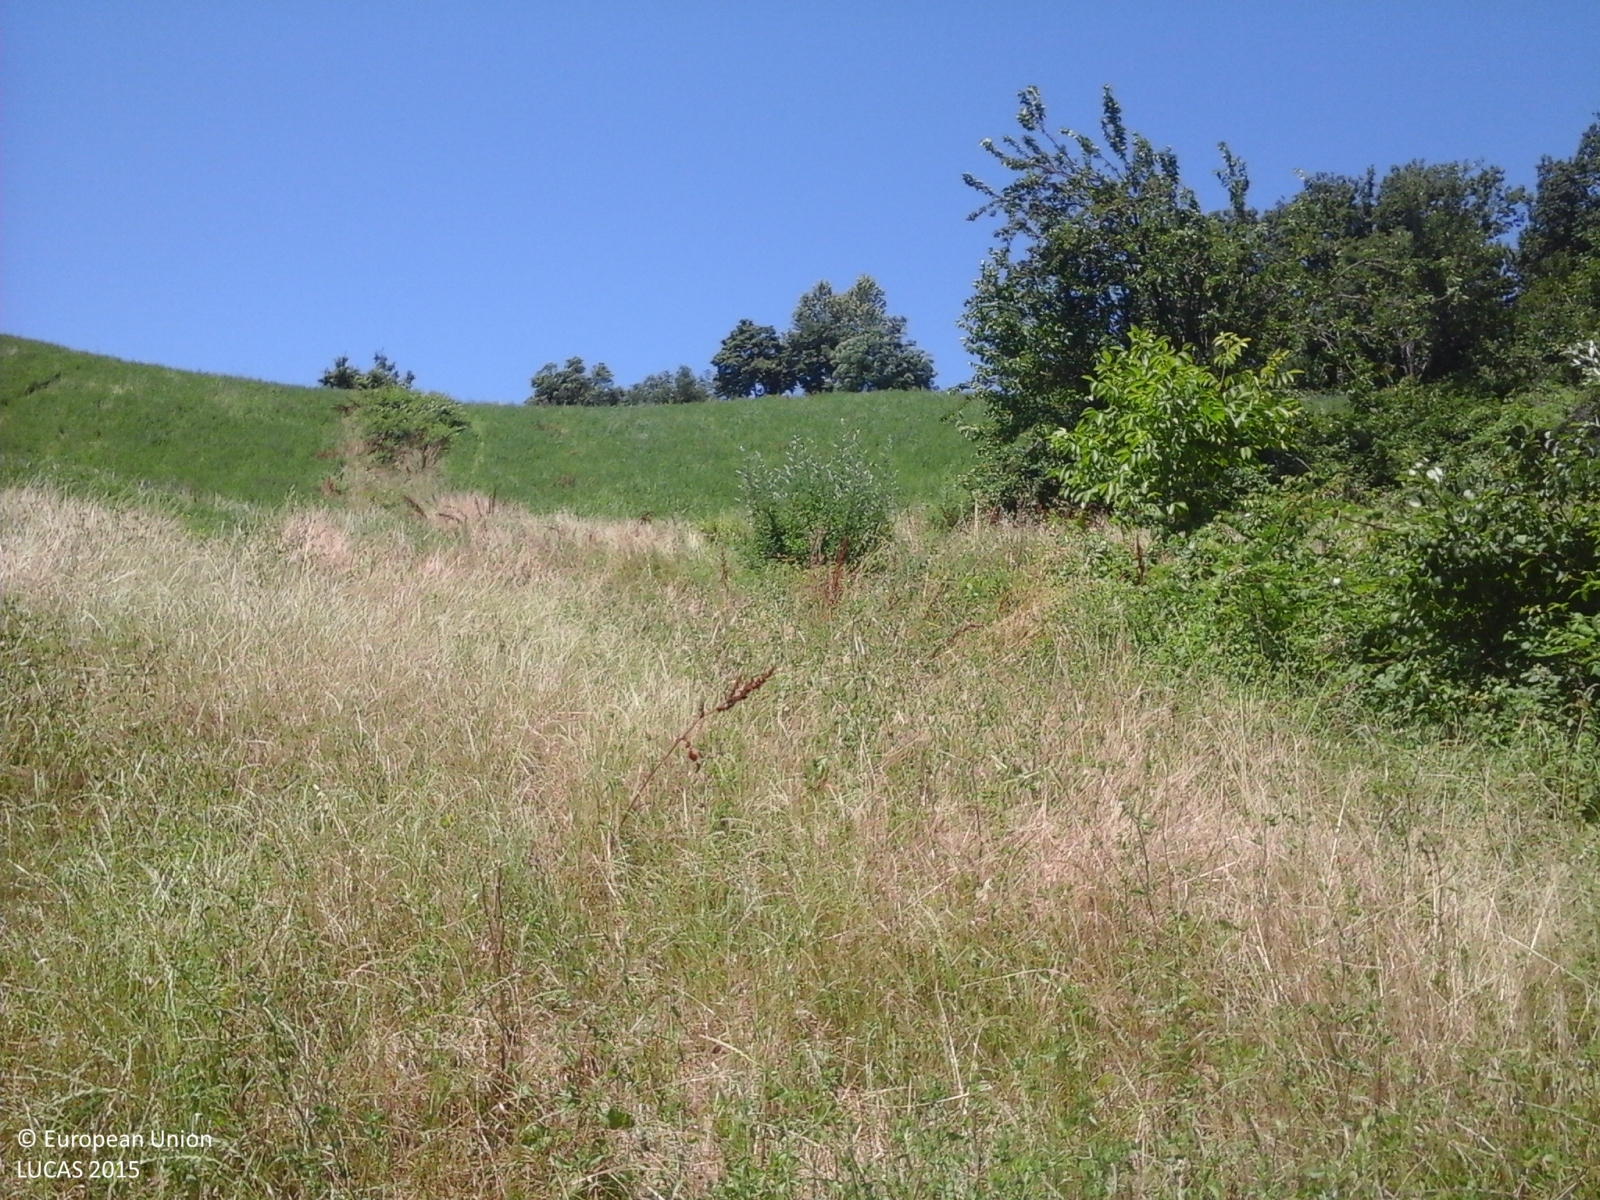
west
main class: Grassland
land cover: Grassland without tree/shrub cover
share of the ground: > 75 %
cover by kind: herbaceous plants 100 %
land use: Agriculture (excluding fallow land and kitchen gardens)
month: June
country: IT
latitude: 44.5288
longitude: 10.6654
